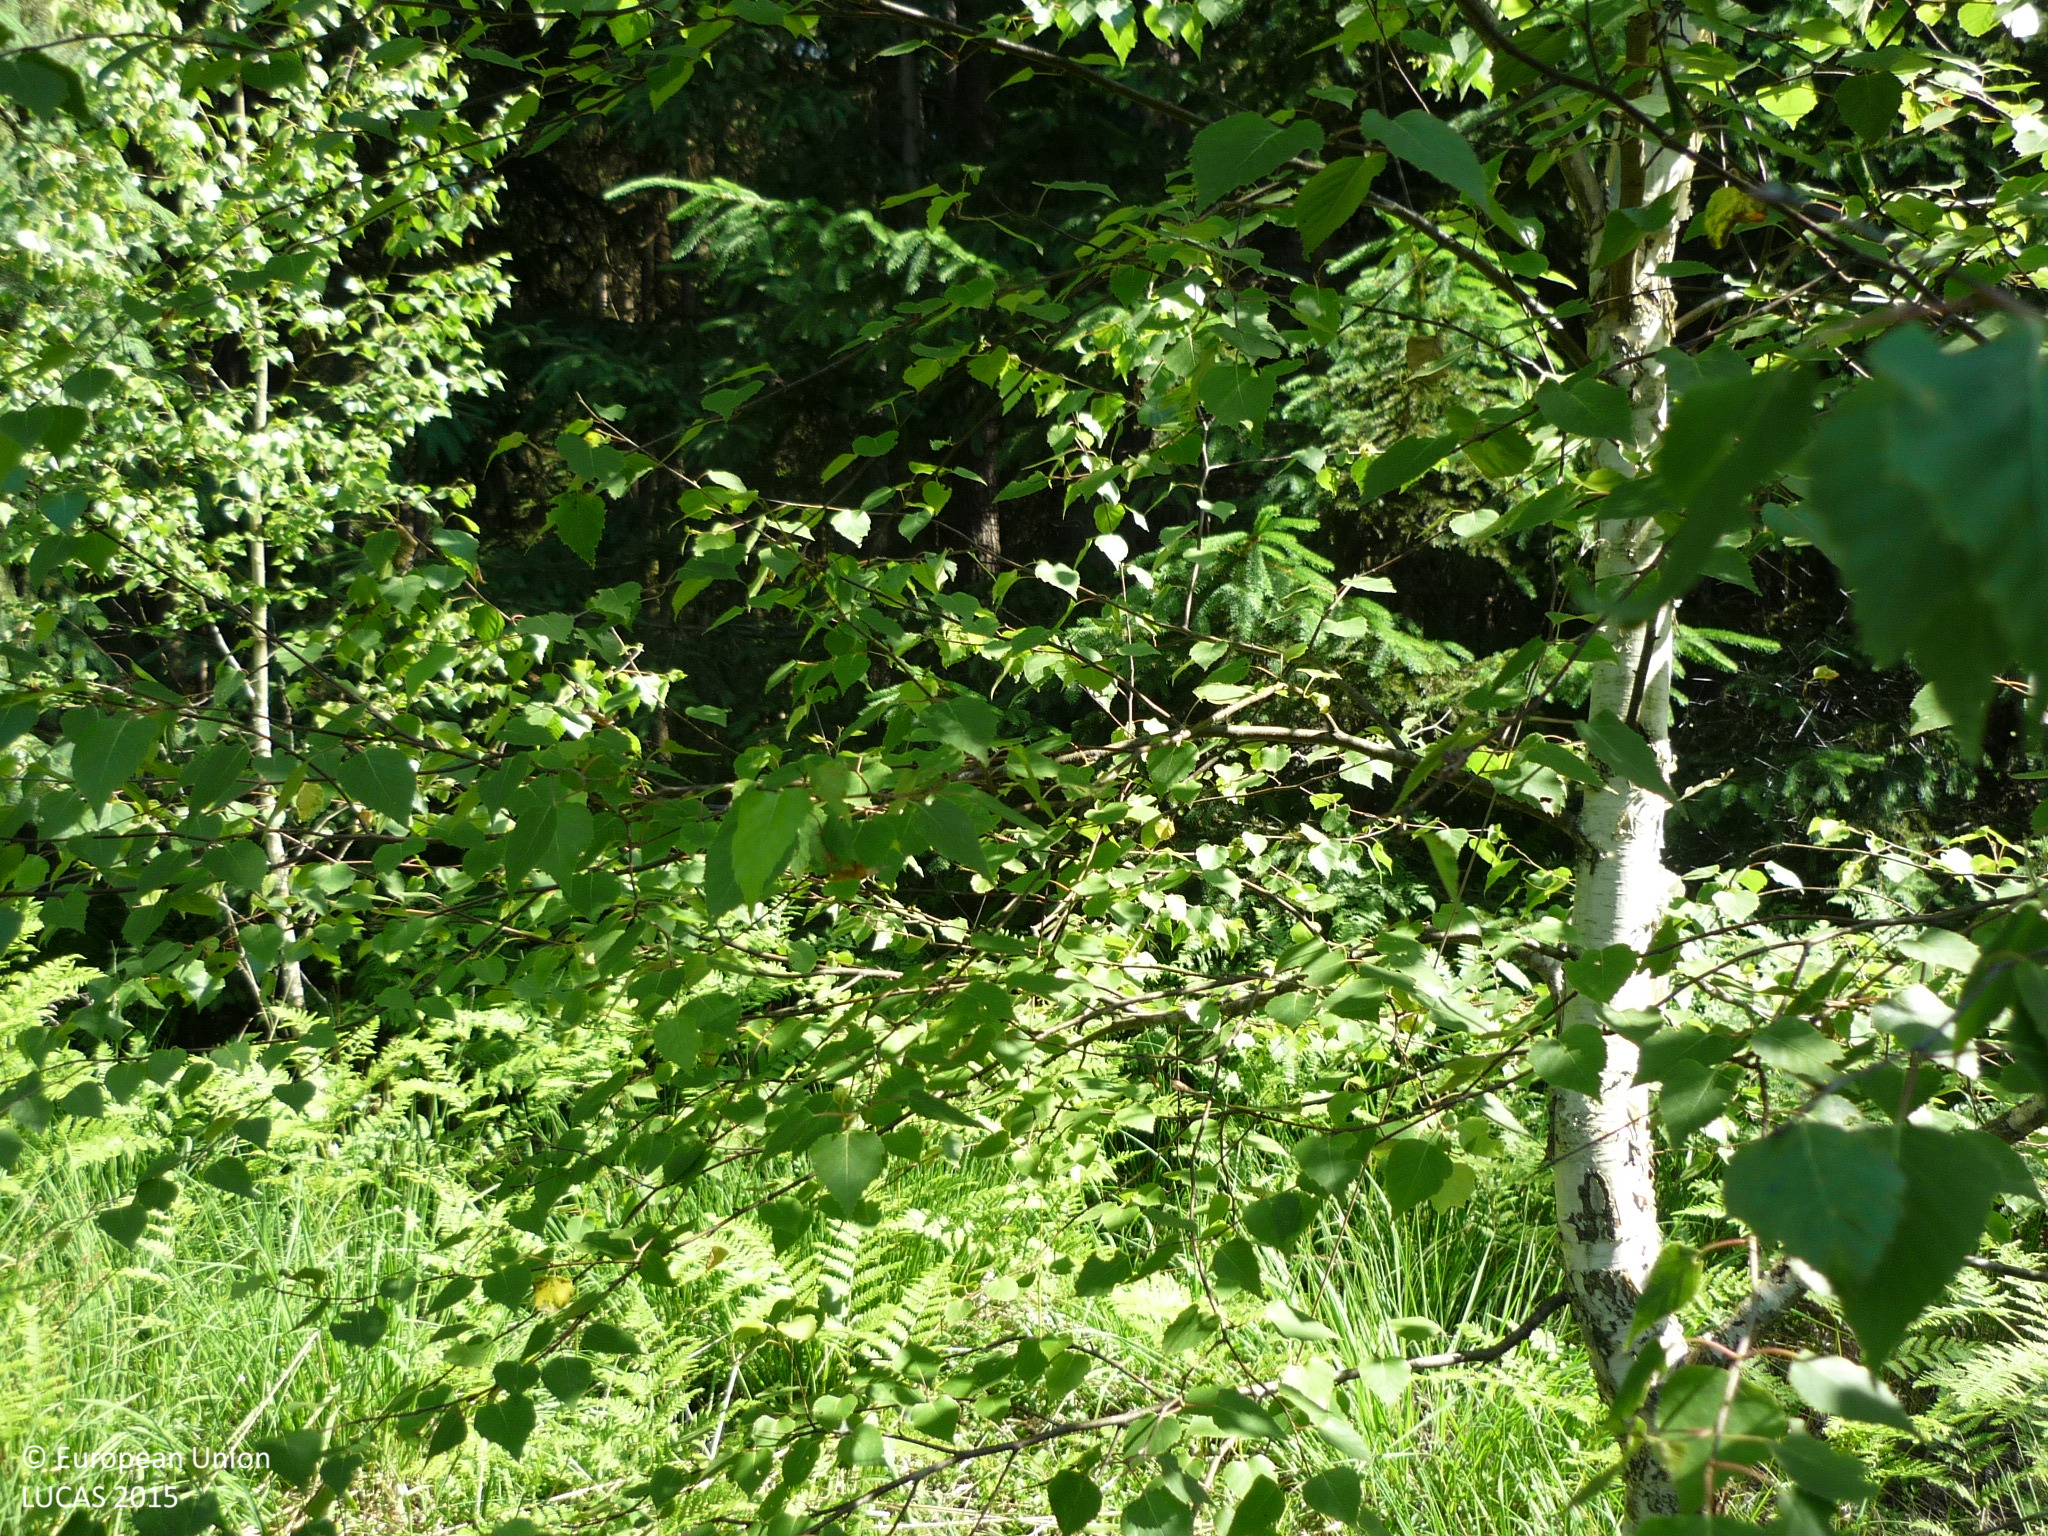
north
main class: Woodland
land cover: Broadleaved woodland
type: non-riverine alder, birch or aspen forest
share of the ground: > 75 %
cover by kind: broadleaved forest trees 50 %, herbaceous plants 40 %, unconsolidated bare surface 10 %
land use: Forestry
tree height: < 5 m
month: June
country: AT
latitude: 46.7771
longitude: 15.6969
